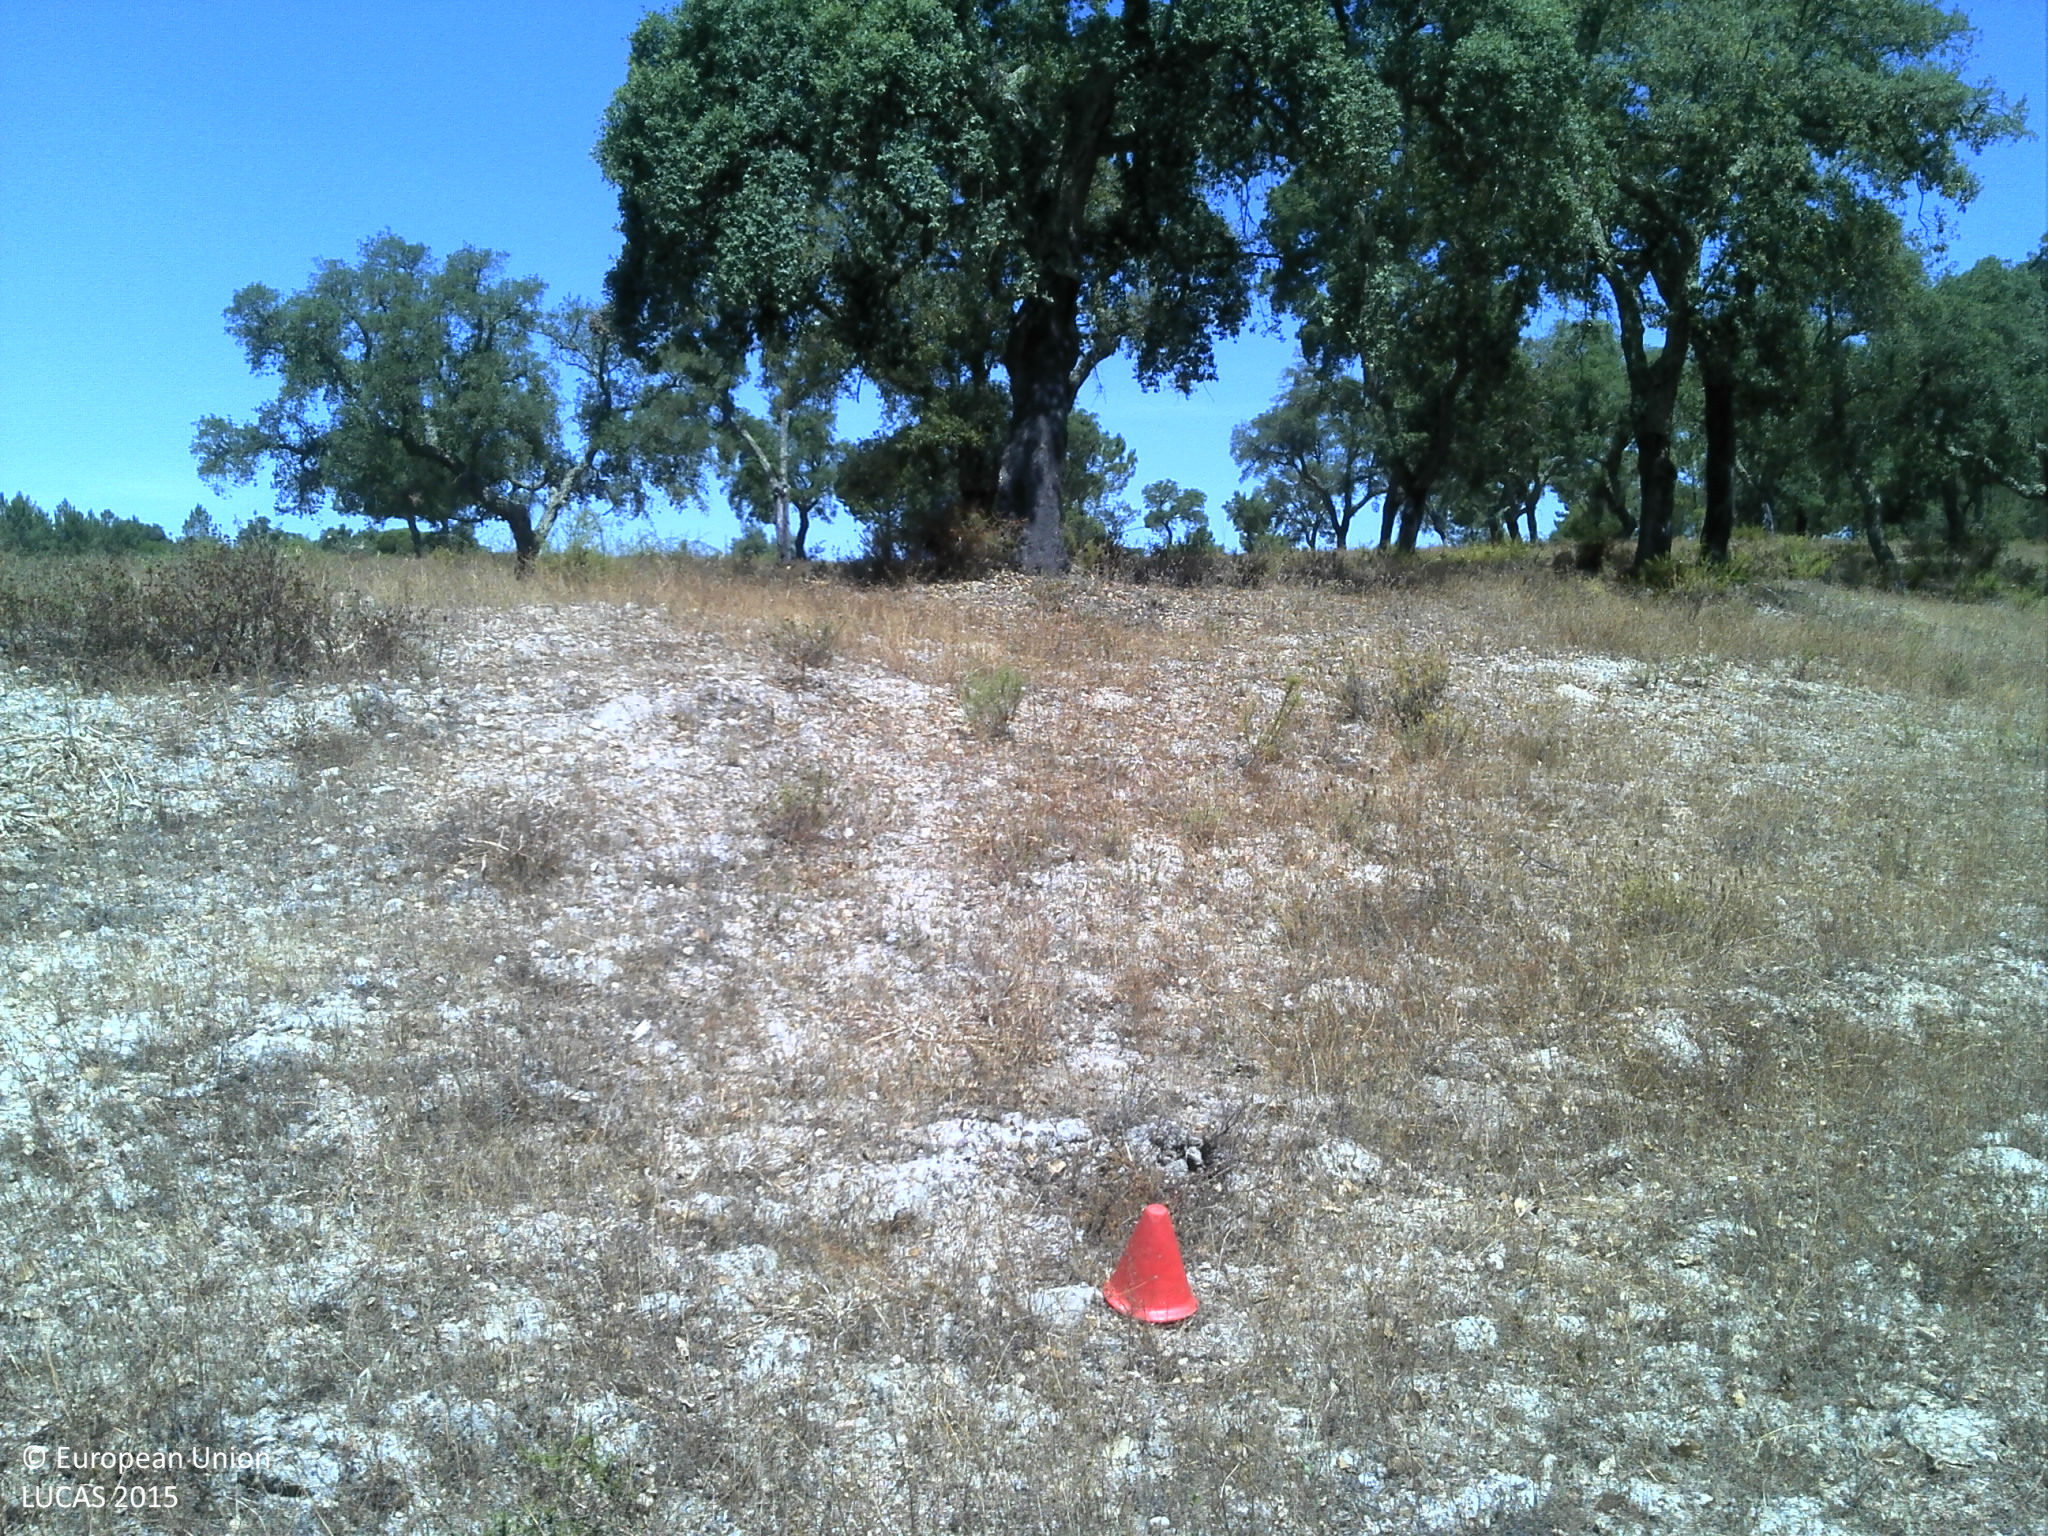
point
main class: Woodland
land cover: Broadleaved woodland
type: broadleaved evergreen forest
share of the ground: 10 - 25 %
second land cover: Grassland without tree/shrub cover
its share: 25 - 50 %
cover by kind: unconsolidated bare surface 55 %, herbaceous plants 25 %, broadleaved forest trees 15 %, shrubs 5 %
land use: Forestry
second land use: Agriculture (excluding fallow land and kitchen gardens)
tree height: > 5 m
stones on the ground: < 10 %
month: July
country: PT
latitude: 39.2130
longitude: -8.2075
